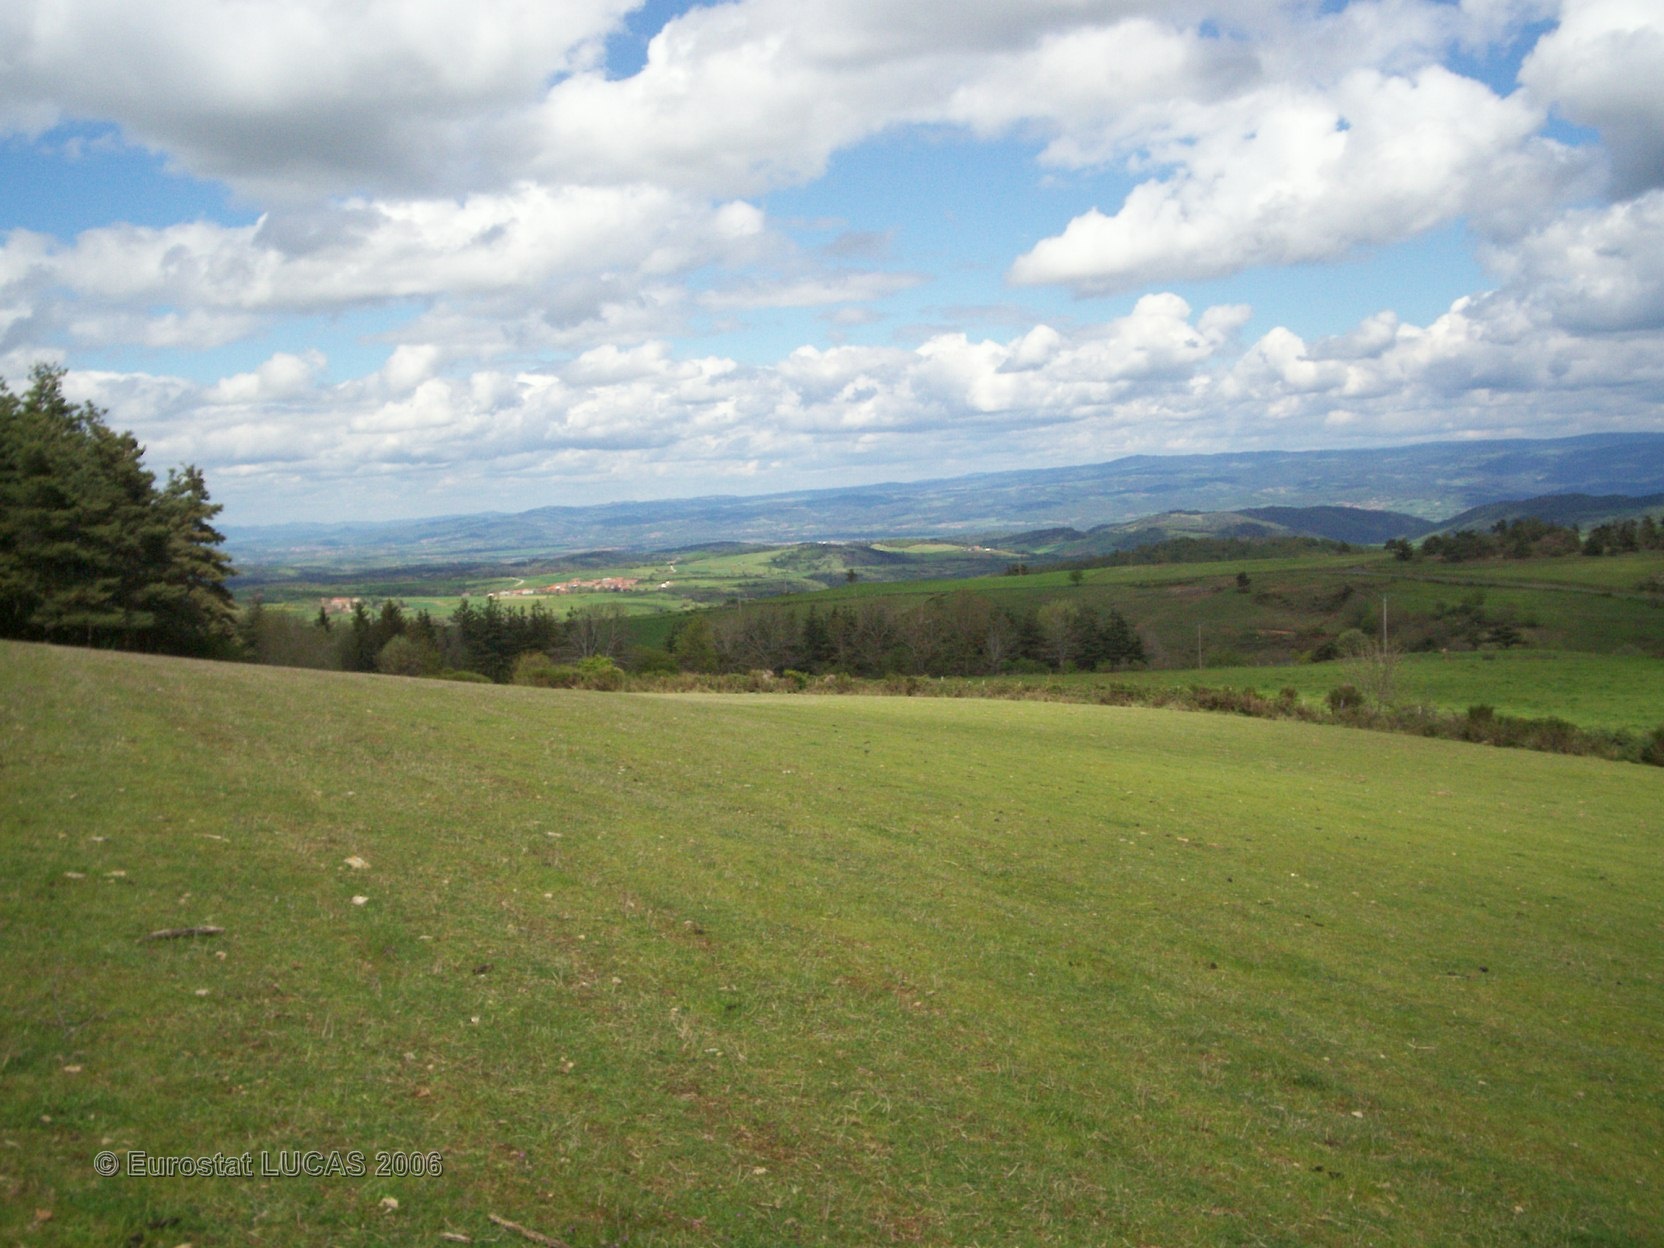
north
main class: Grassland
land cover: Grassland without tree/shrub cover
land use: Agriculture (excluding fallow land and kitchen gardens)
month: May
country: FR
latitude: 45.2023
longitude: 3.3187
